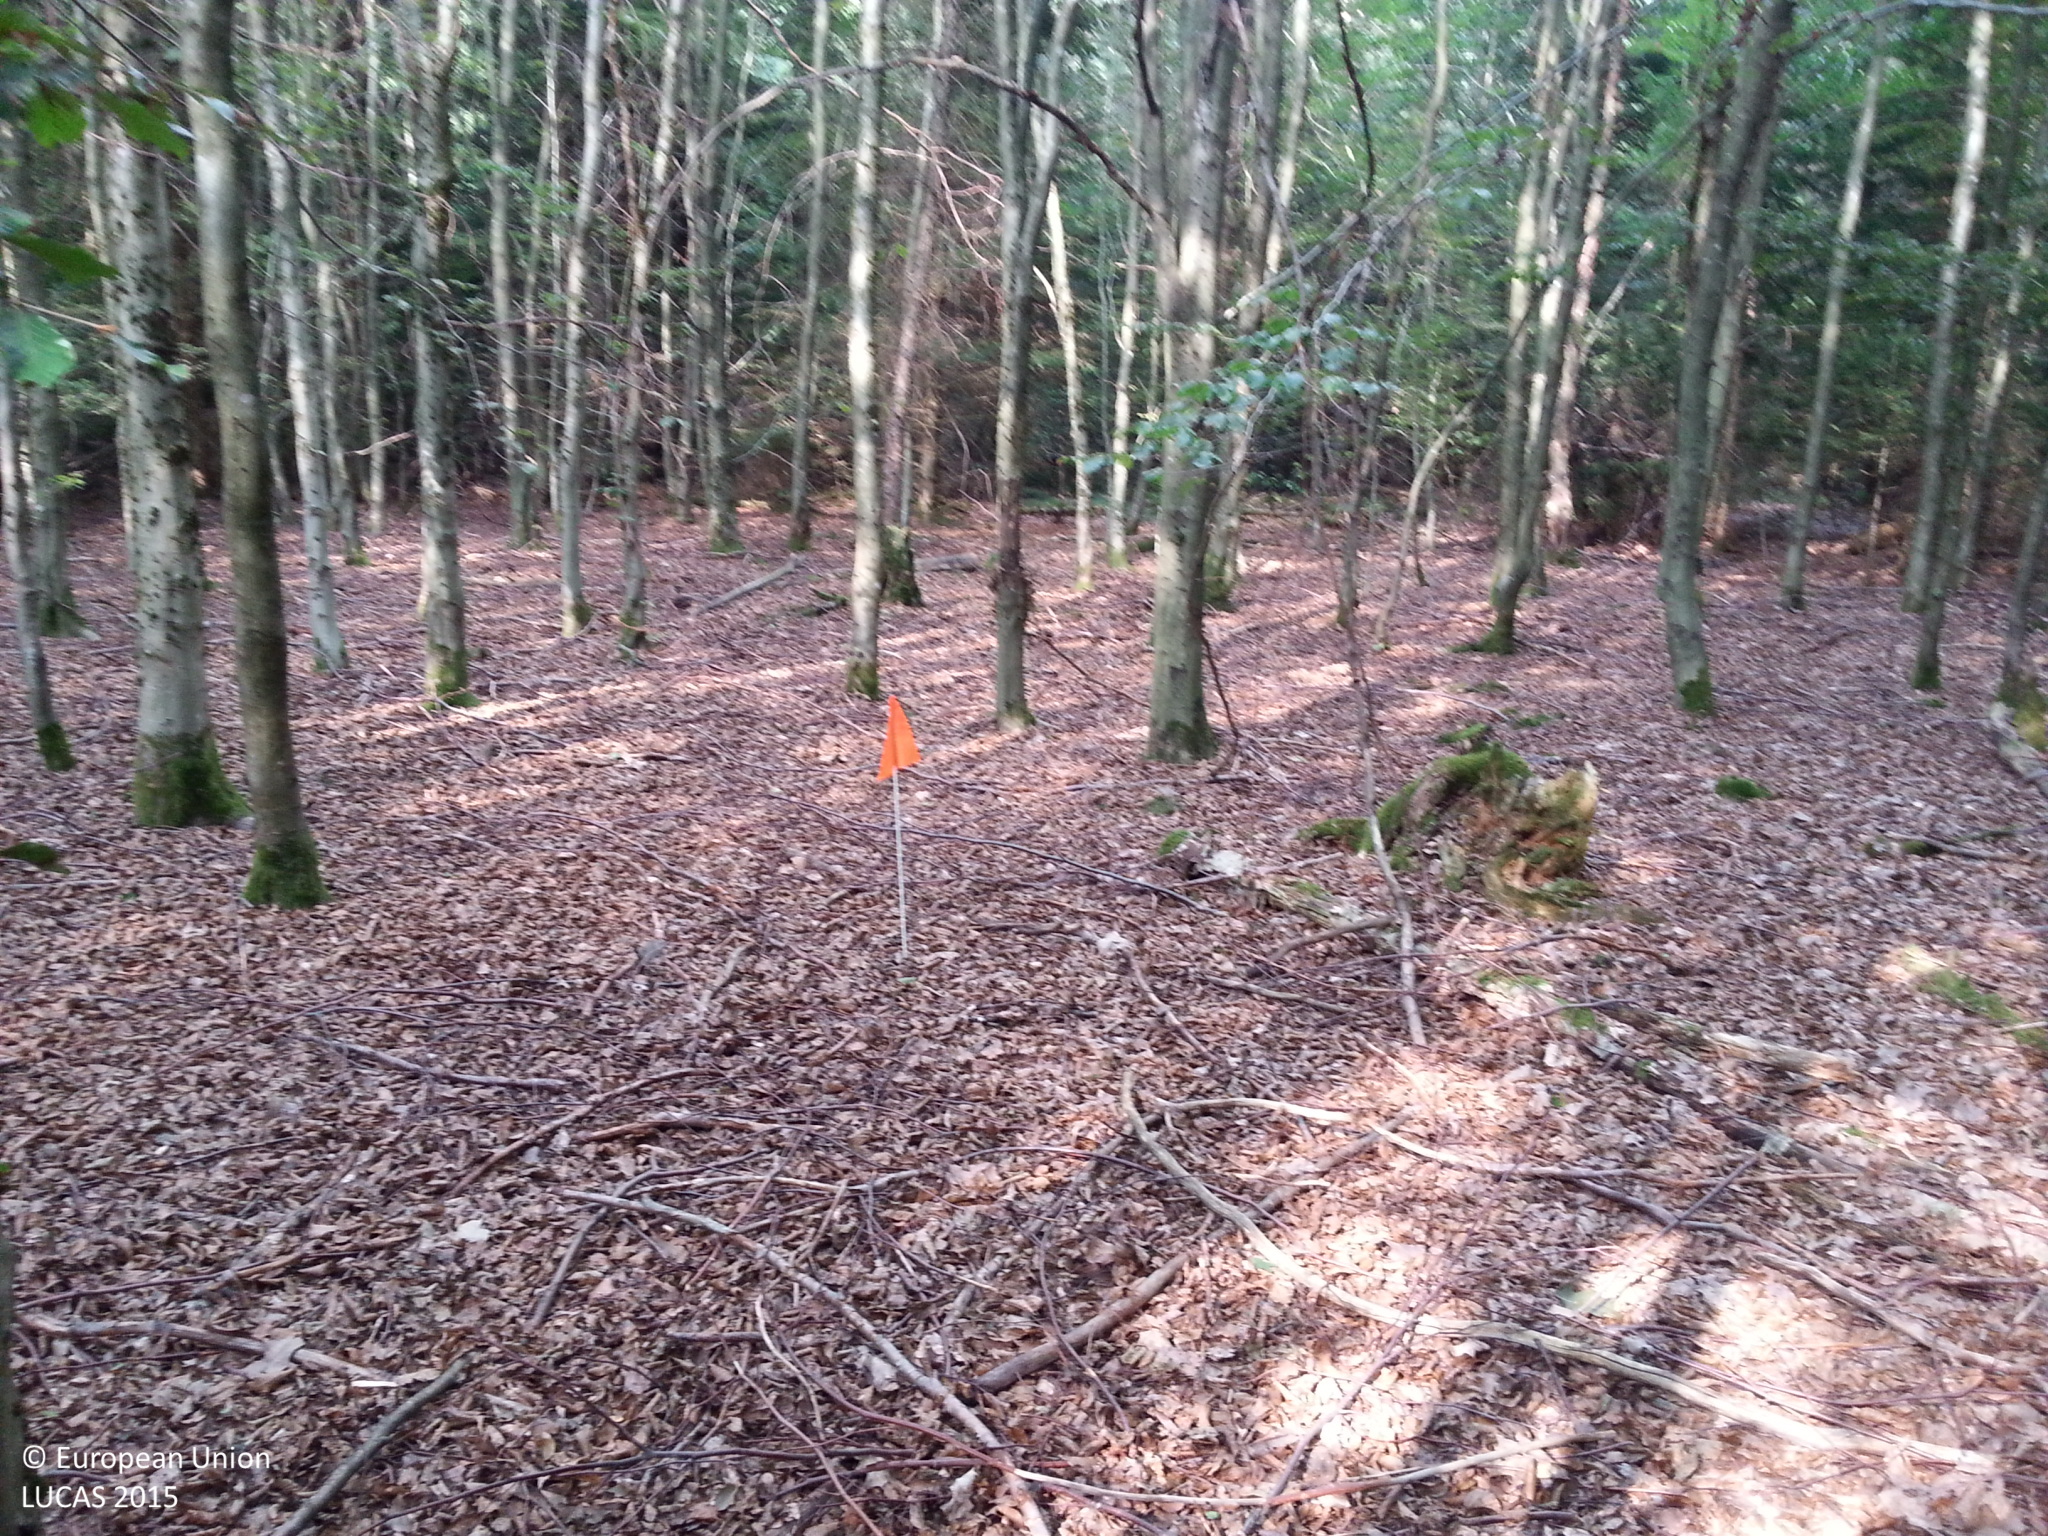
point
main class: Woodland
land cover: Broadleaved woodland
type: beech forest
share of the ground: > 75 %
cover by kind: broadleaved forest trees 85 %, unconsolidated bare surface 15 %
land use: Forestry
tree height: > 5 m
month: September
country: DE
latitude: 49.5339
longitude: 9.1851
